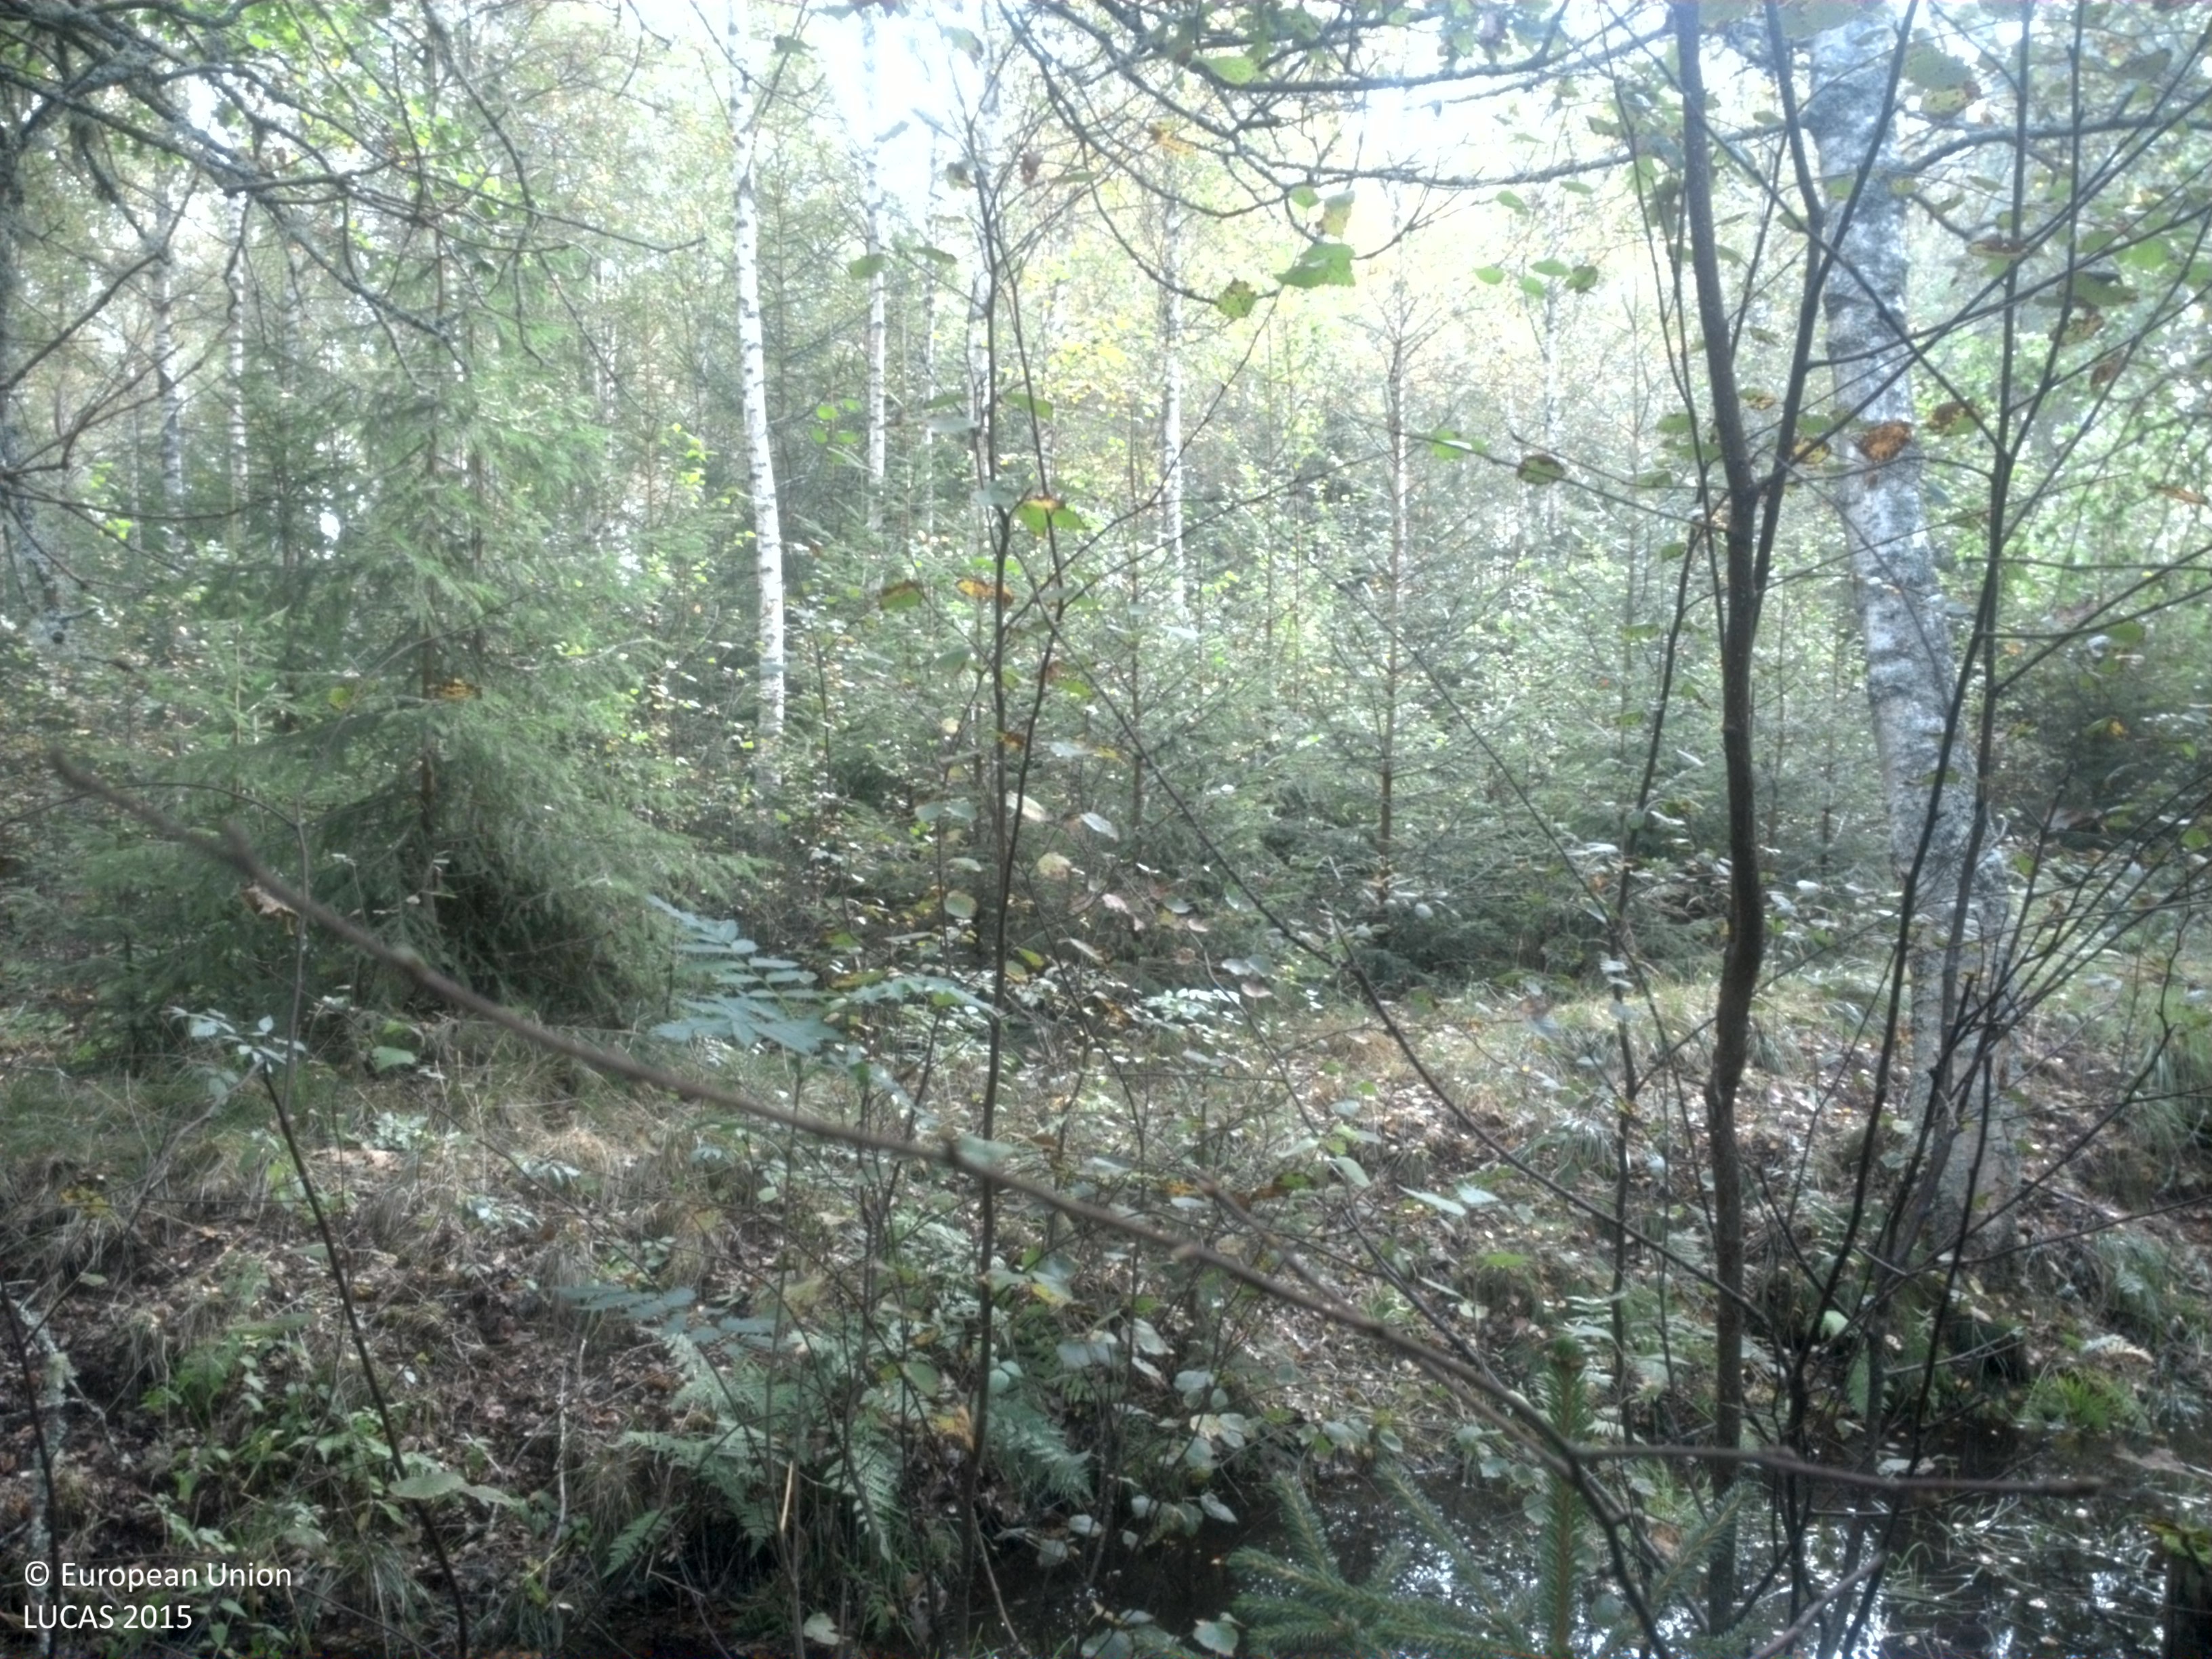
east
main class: Woodland
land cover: Spruce dominated mixed woodland
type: boreal forest
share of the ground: > 75 %
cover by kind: broadleaved forest trees 50 %, coniferous forest trees 25 %, unconsolidated bare surface 10 %, shrubs 5 %, herbaceous plants 5 %
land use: Forestry
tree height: > 5 m
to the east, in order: Spruce dominated mixed woodland; Rivers and streams; Spruce dominated mixed woodland; Pine dominated mixed woodland
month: September
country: SE
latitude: 59.5569
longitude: 15.7771
